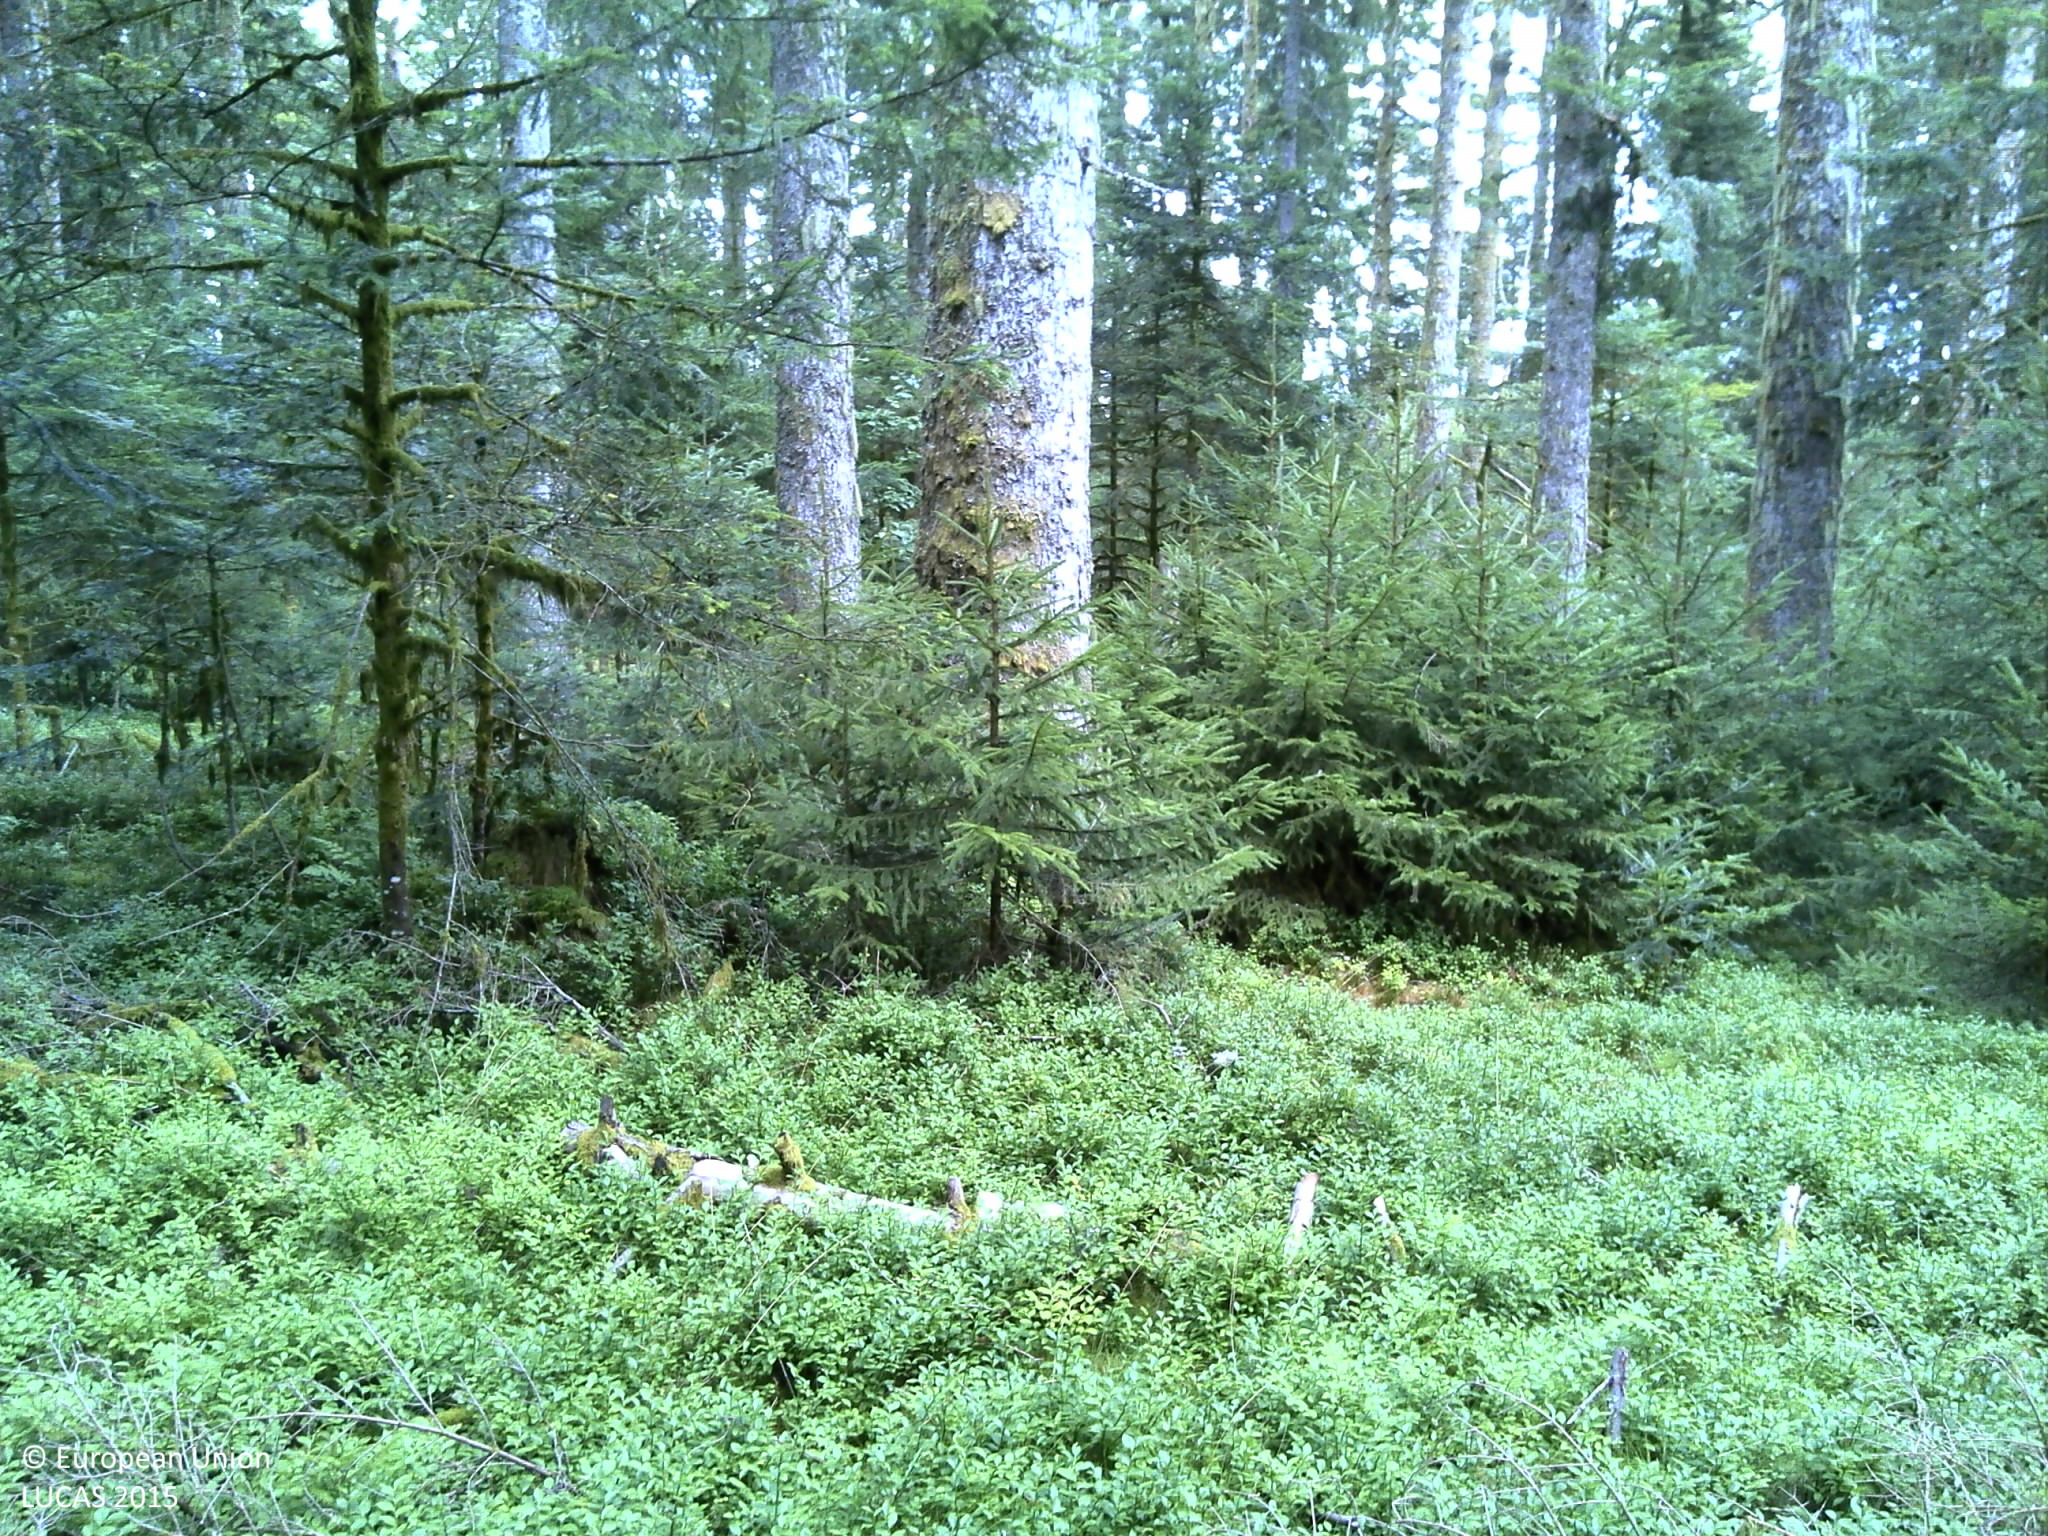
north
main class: Woodland
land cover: Spruce dominated coniferous woodland
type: alpine coniferous forest
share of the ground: > 75 %
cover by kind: coniferous forest trees 90 %, shrubs 10 %
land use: Forestry
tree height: > 5 m
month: August
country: FR
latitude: 48.1064
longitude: 6.8449
